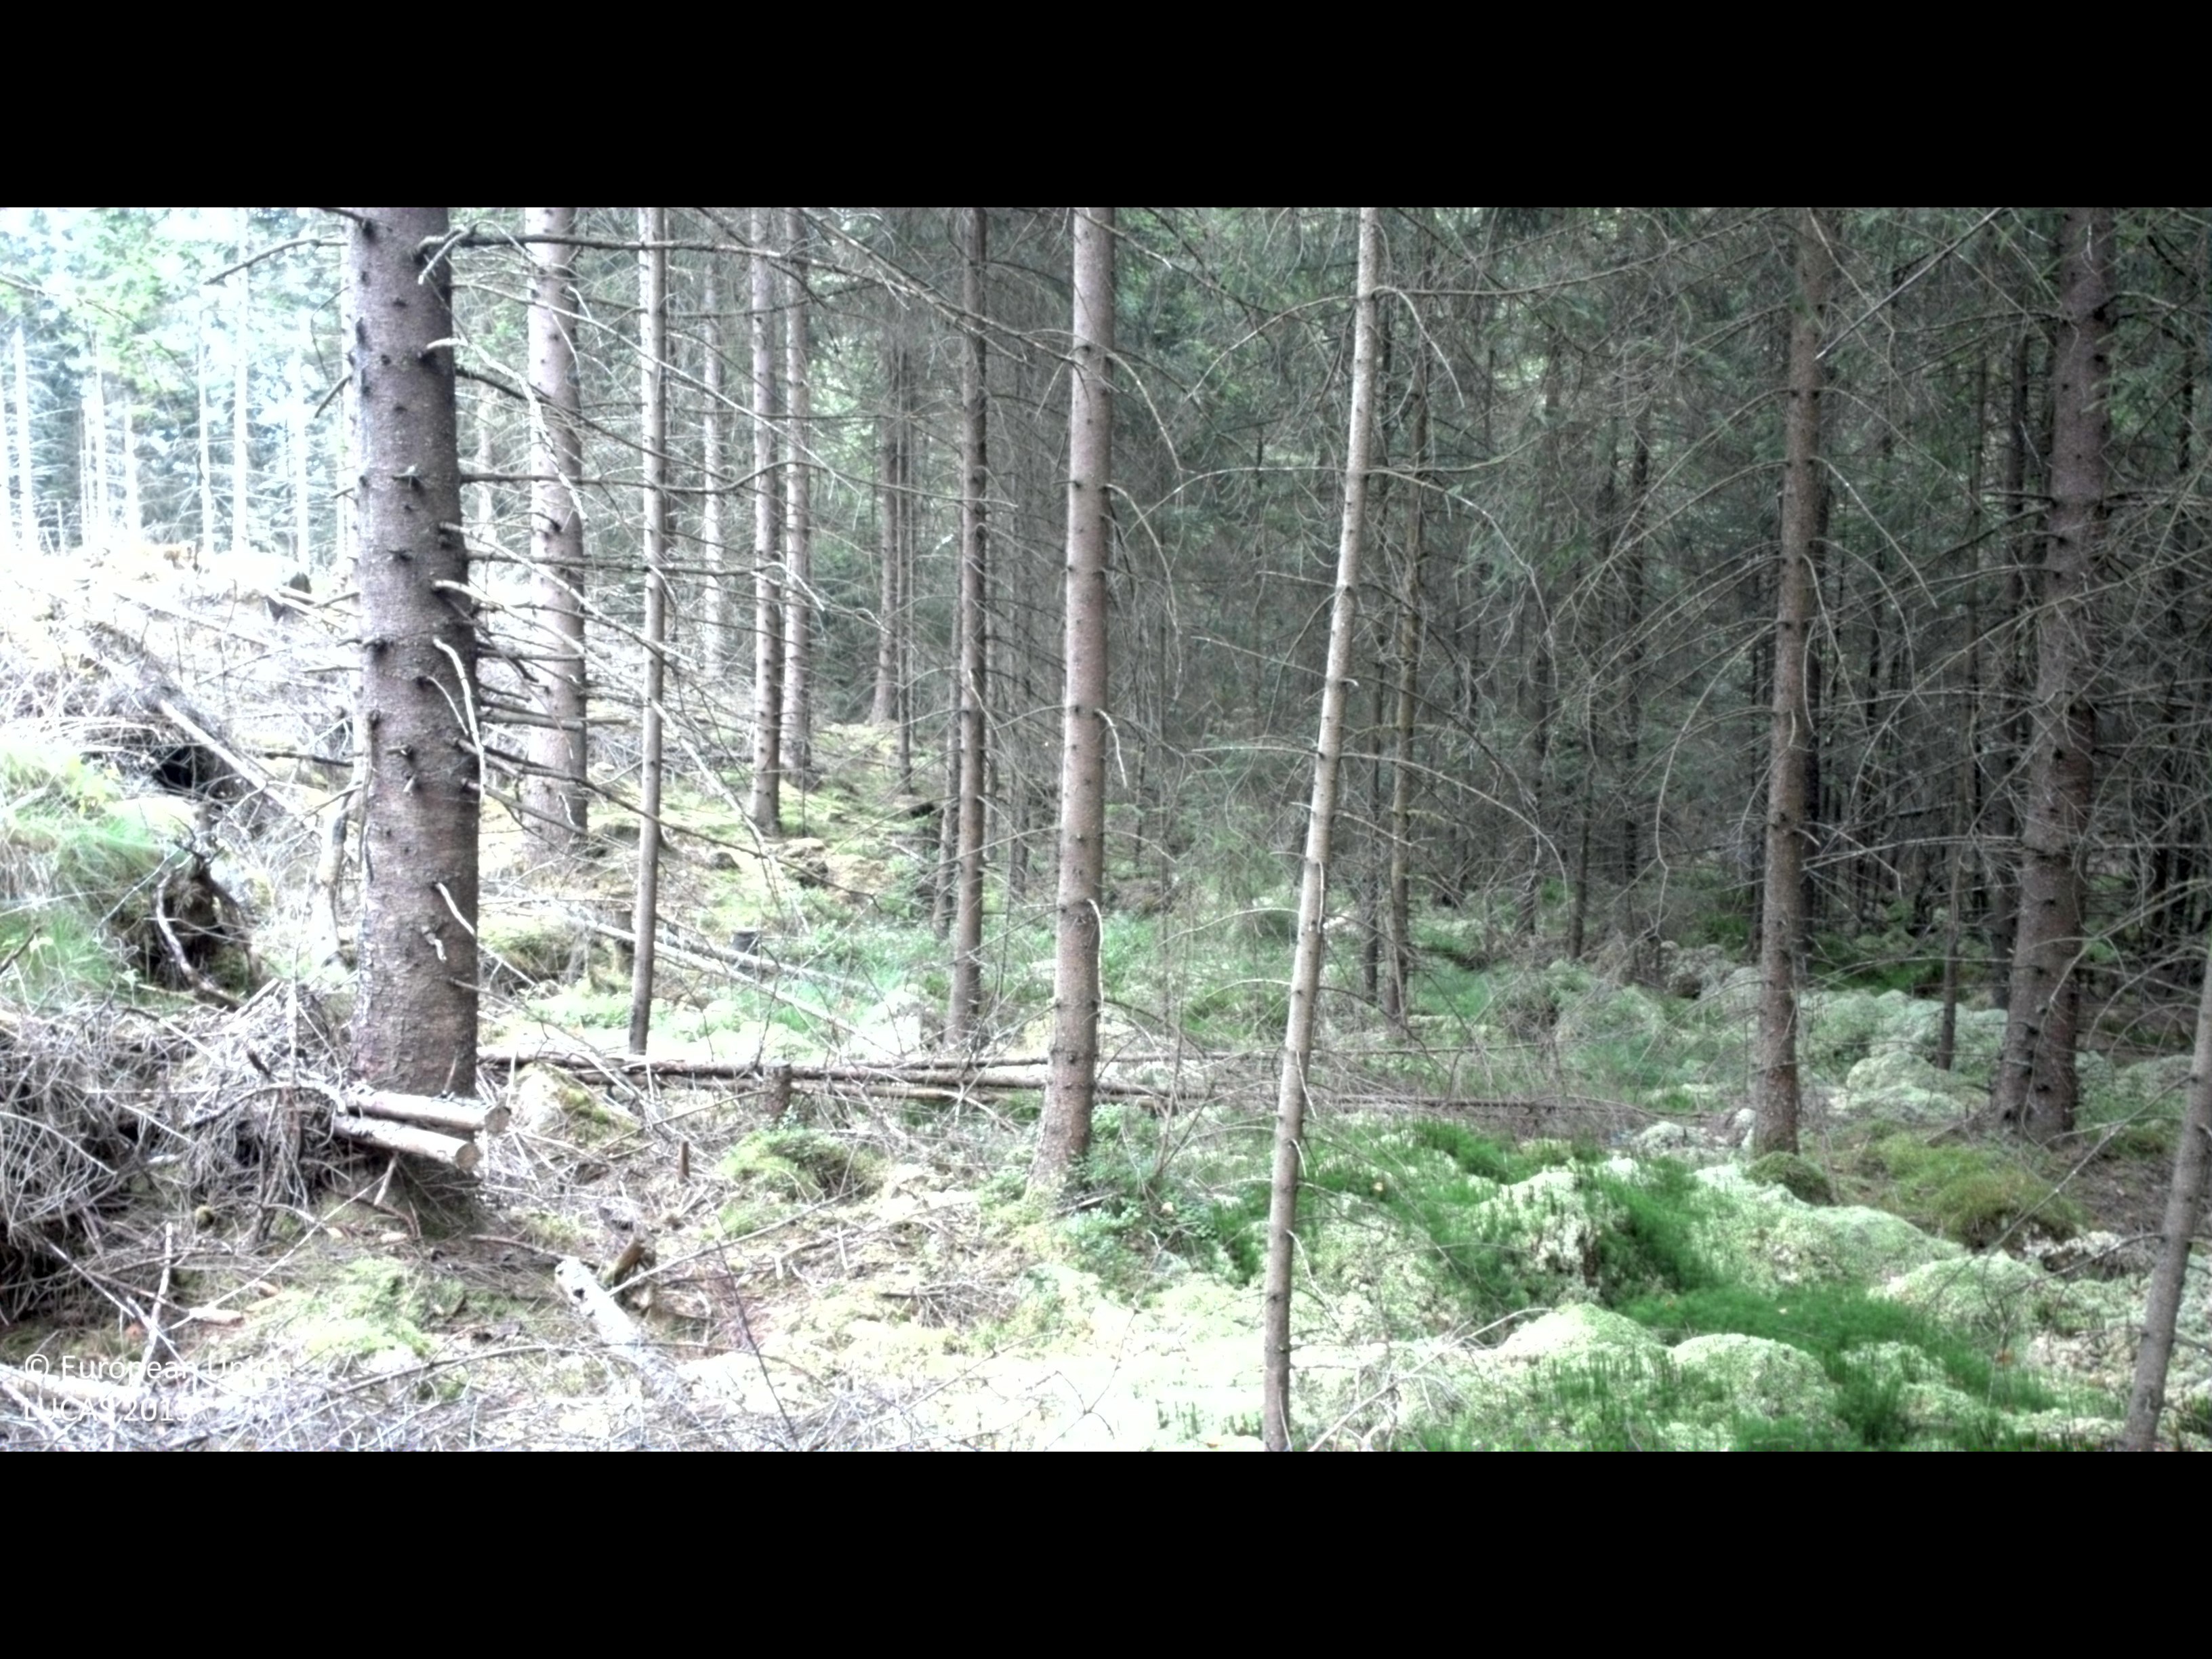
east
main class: Woodland
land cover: Spruce dominated coniferous woodland
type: boreal forest
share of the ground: > 75 %
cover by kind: coniferous forest trees 70 %, lichens and mosses 25 %, broadleaved forest trees 5 %
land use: Forestry
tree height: > 5 m
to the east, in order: Spruce dominated coniferous woodland; Ditches and canals; Spruce dominated coniferous woodland; Grassland with sparse tree/shrub cover; Spruce dominated coniferous woodland
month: August
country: SE
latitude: 56.8318
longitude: 13.1924
